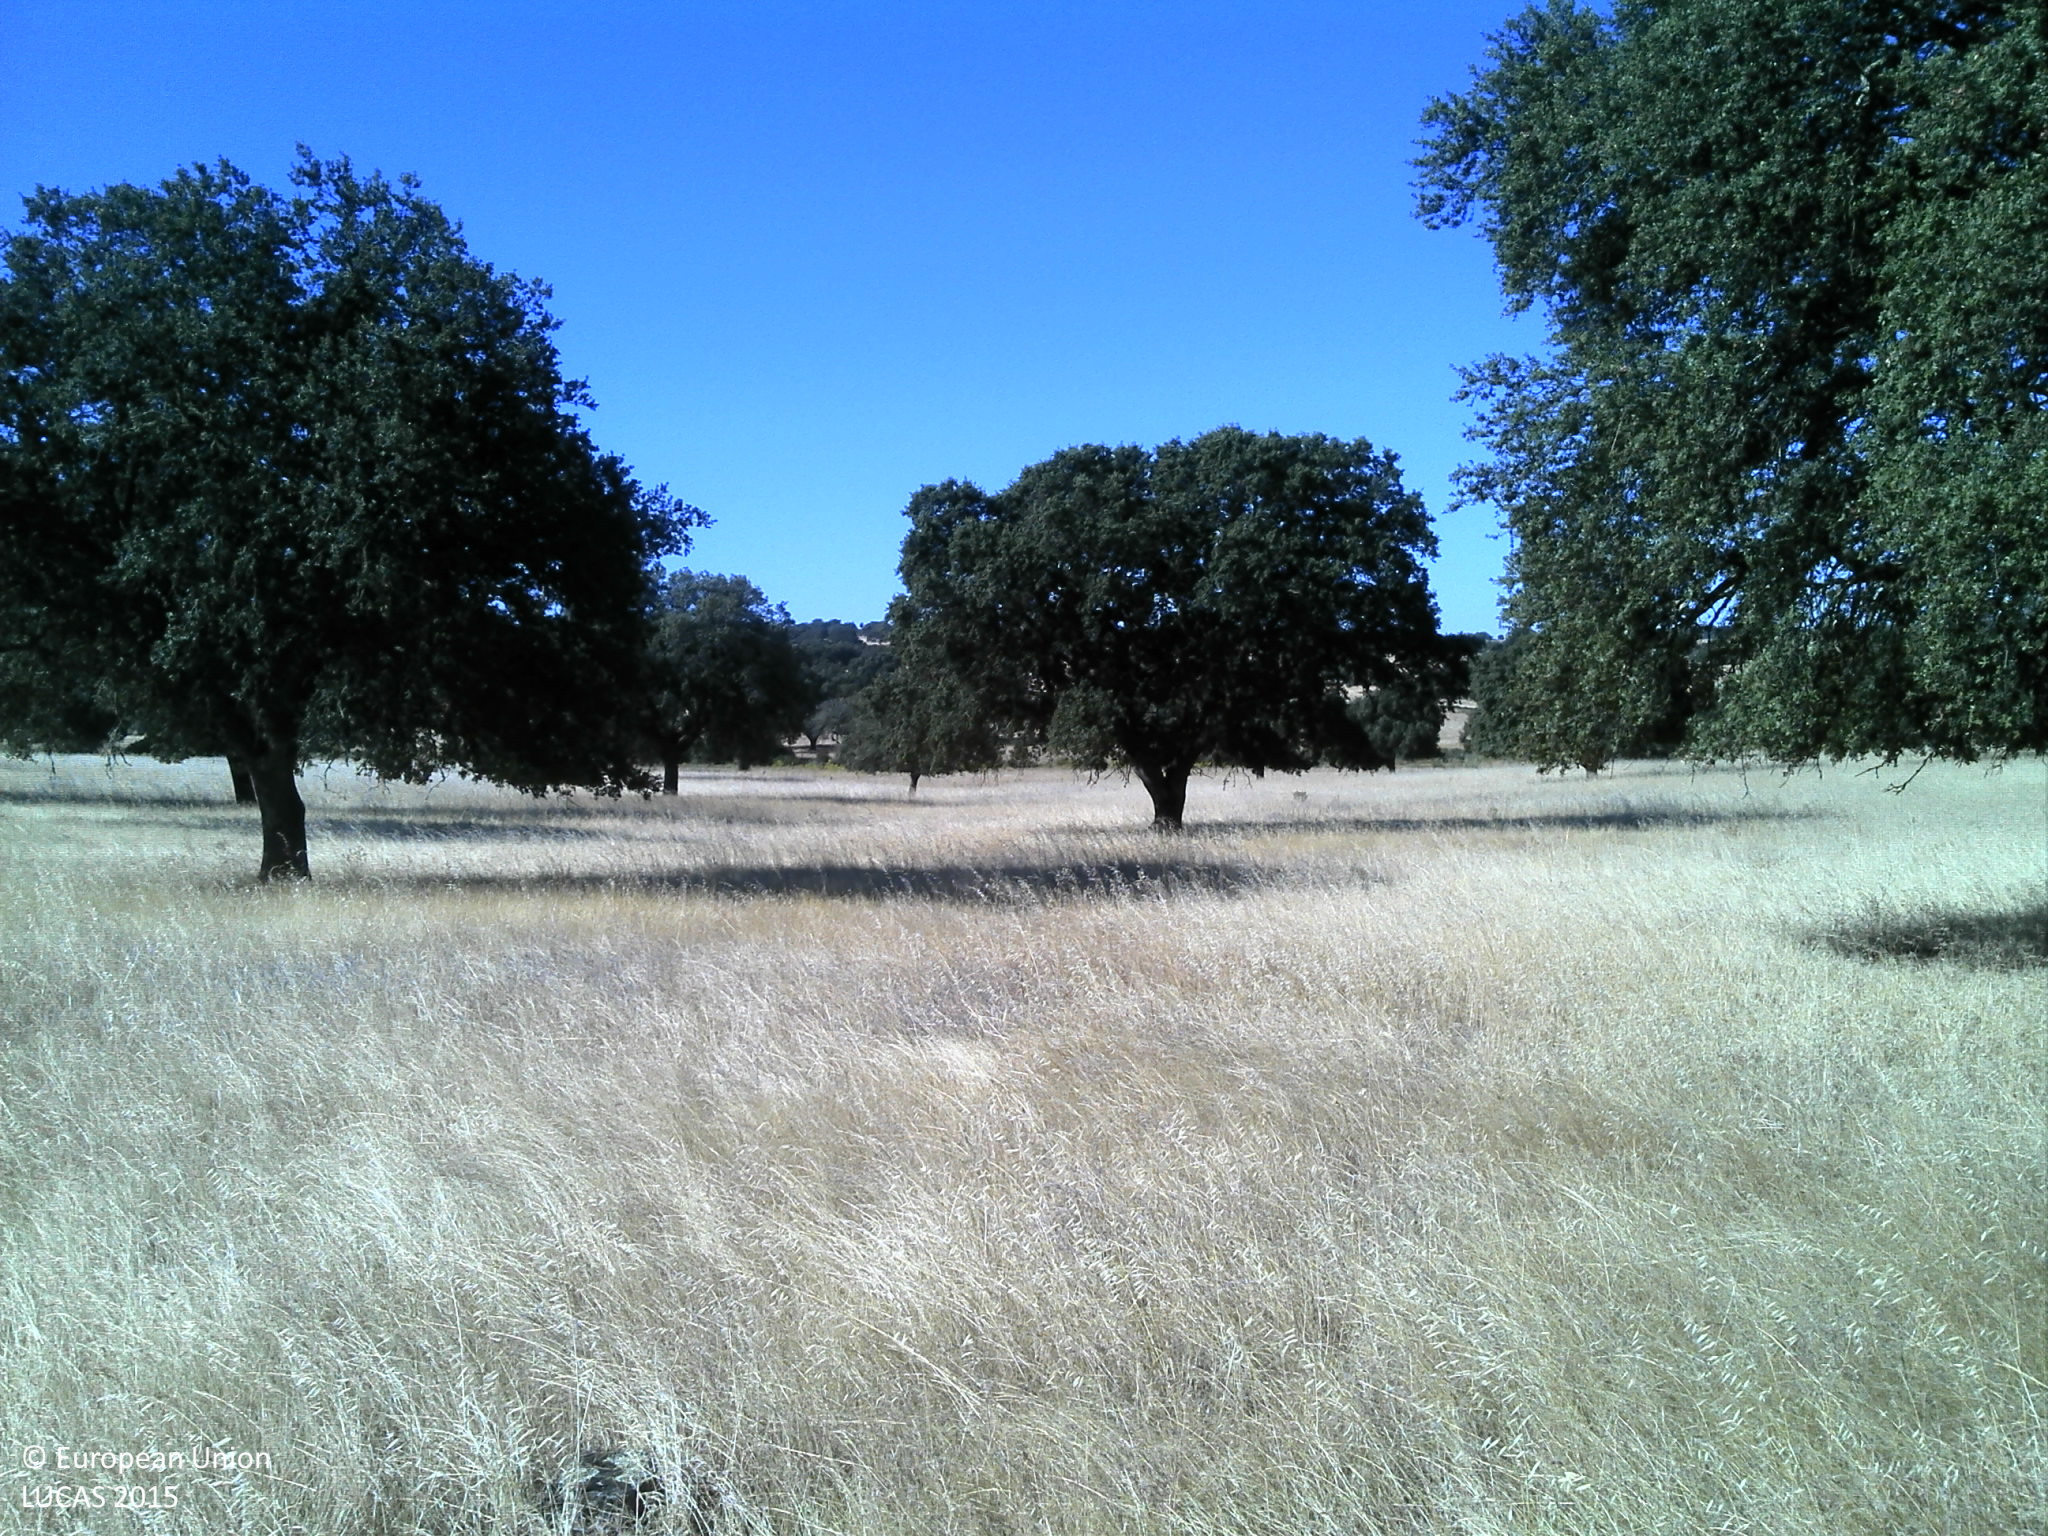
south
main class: Woodland
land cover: Broadleaved woodland
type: broadleaved evergreen forest
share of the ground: 10 - 25 %
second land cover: Grassland without tree/shrub cover
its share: 50 - 75 %
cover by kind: herbaceous plants 60 %, unconsolidated bare surface 25 %, broadleaved forest trees 15 %
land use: Forestry
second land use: Agriculture (excluding fallow land and kitchen gardens)
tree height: > 5 m
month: July
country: PT
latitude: 38.9612
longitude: -7.3795
